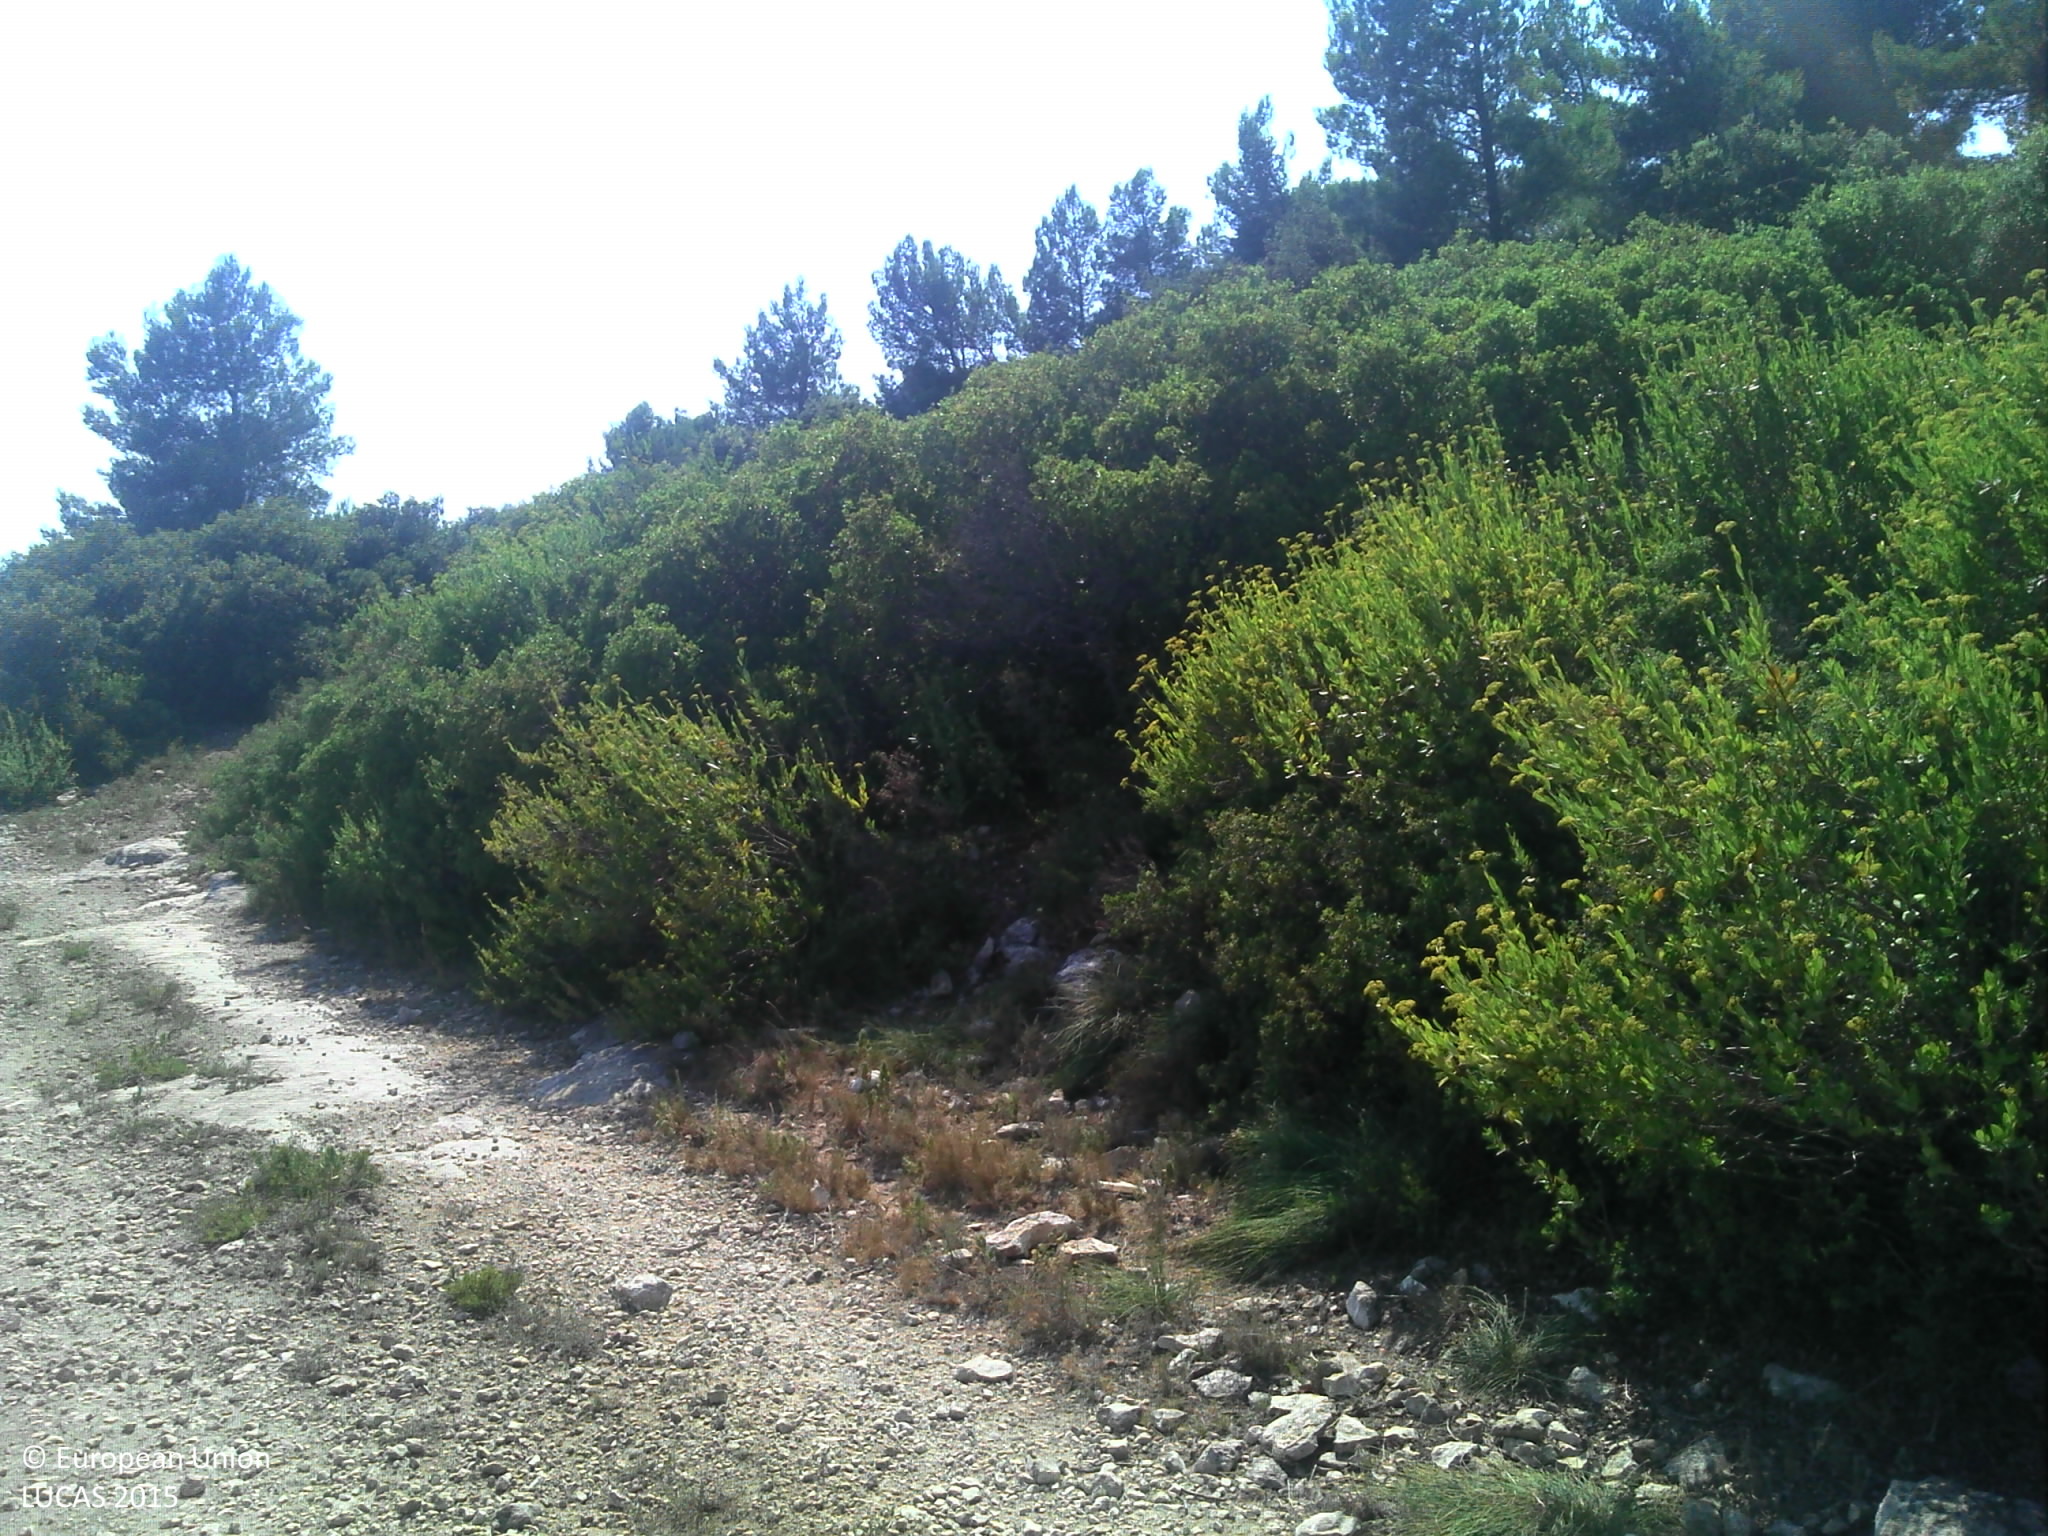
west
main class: Shrubland
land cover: Shrubland without tree cover
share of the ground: > 75 %
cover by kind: shrubs 75 %, herbaceous plants 25 %
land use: Semi-natural and natural areas not in use
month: July
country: FR
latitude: 43.7468
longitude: 4.7315
